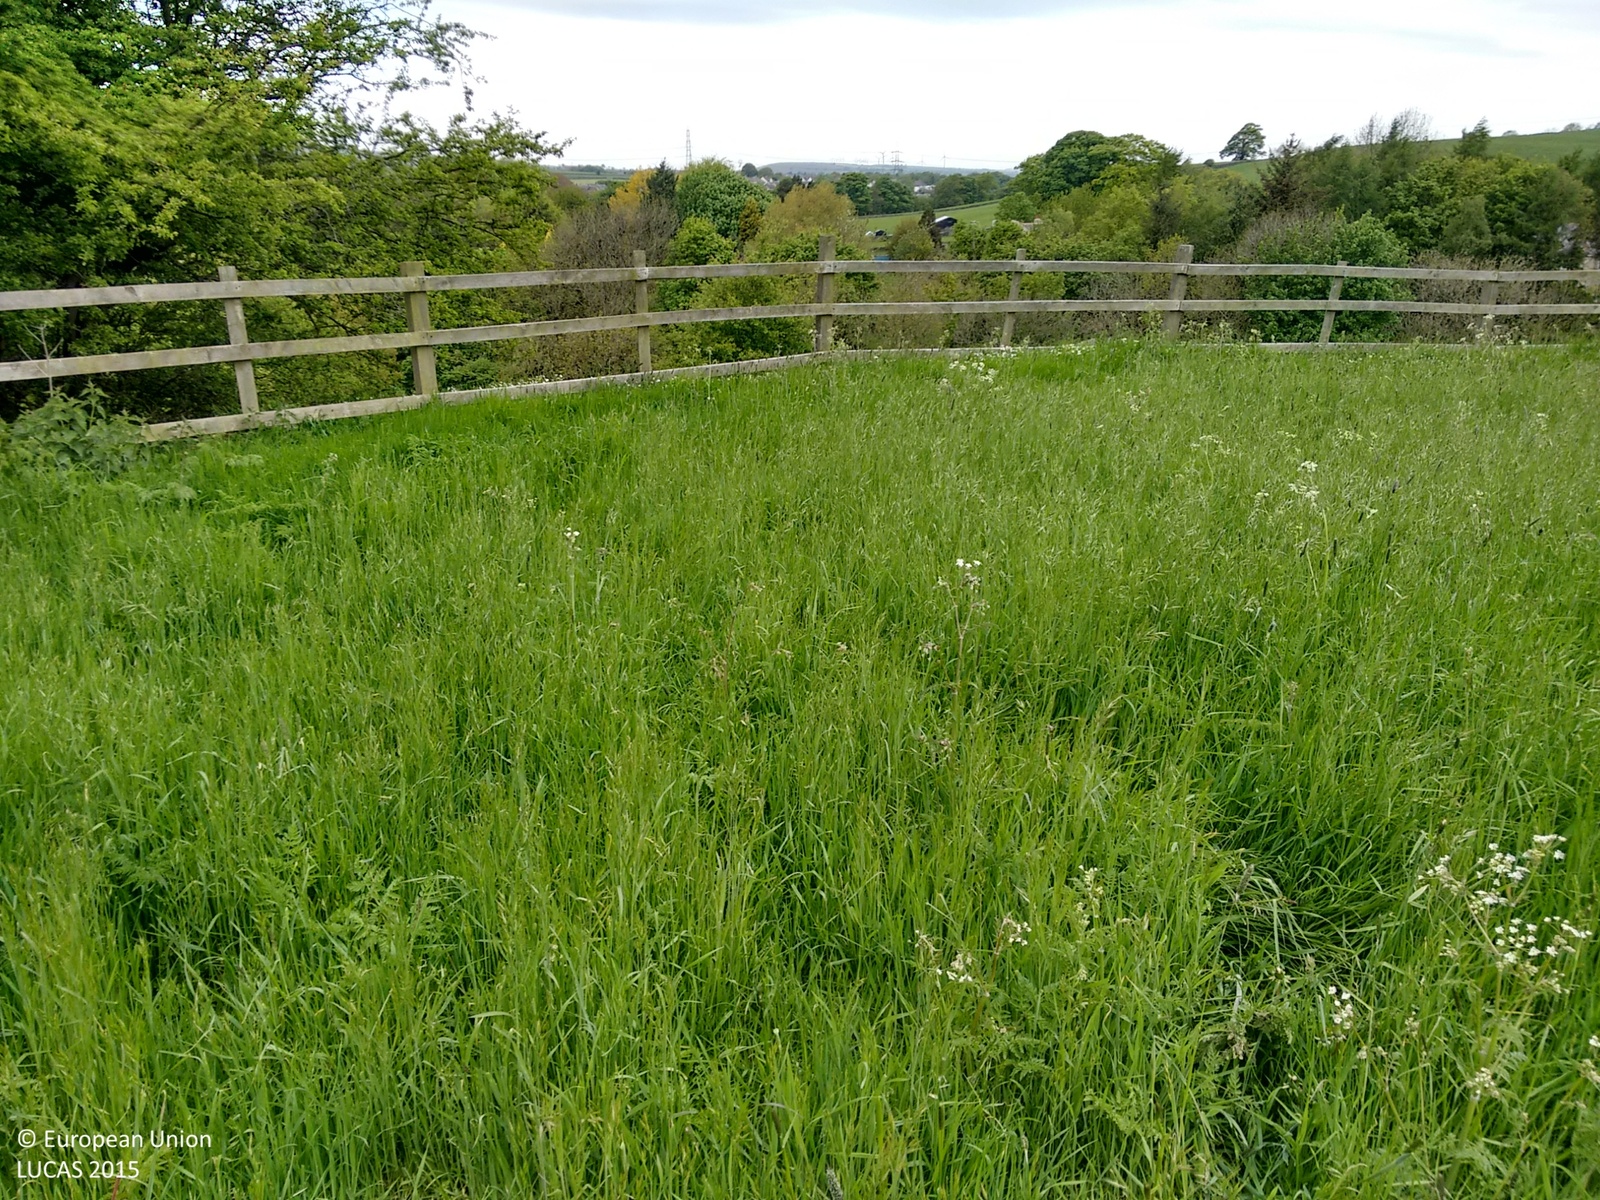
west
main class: Grassland
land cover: Grassland without tree/shrub cover
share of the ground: > 75 %
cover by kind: herbaceous plants 100 %
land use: Agriculture (excluding fallow land and kitchen gardens)
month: May
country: GB
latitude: 53.5157
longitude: -1.5883
